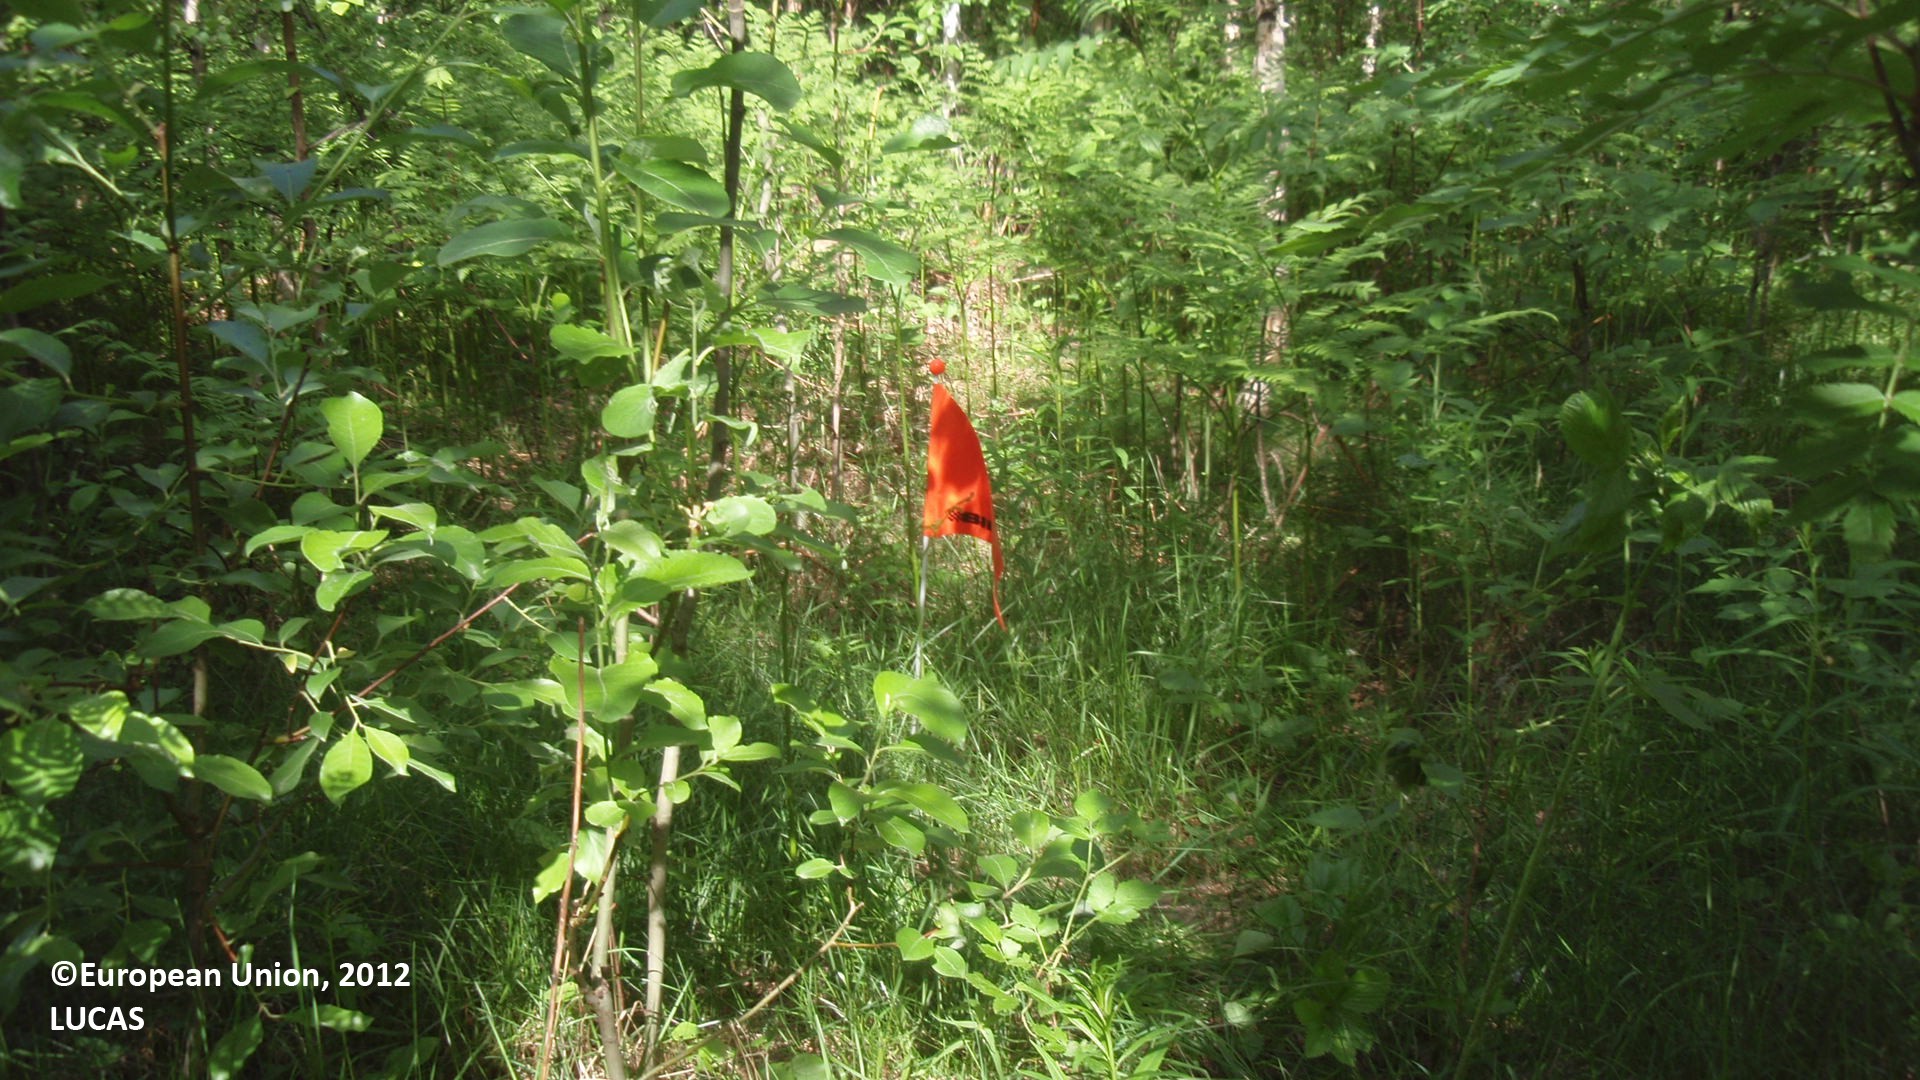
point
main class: Woodland
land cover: Broadleaved woodland
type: non-riverine alder, birch or aspen forest
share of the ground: > 75 %
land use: Forestry
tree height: < 5 m
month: June
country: FI
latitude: 61.6623
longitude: 28.4319
